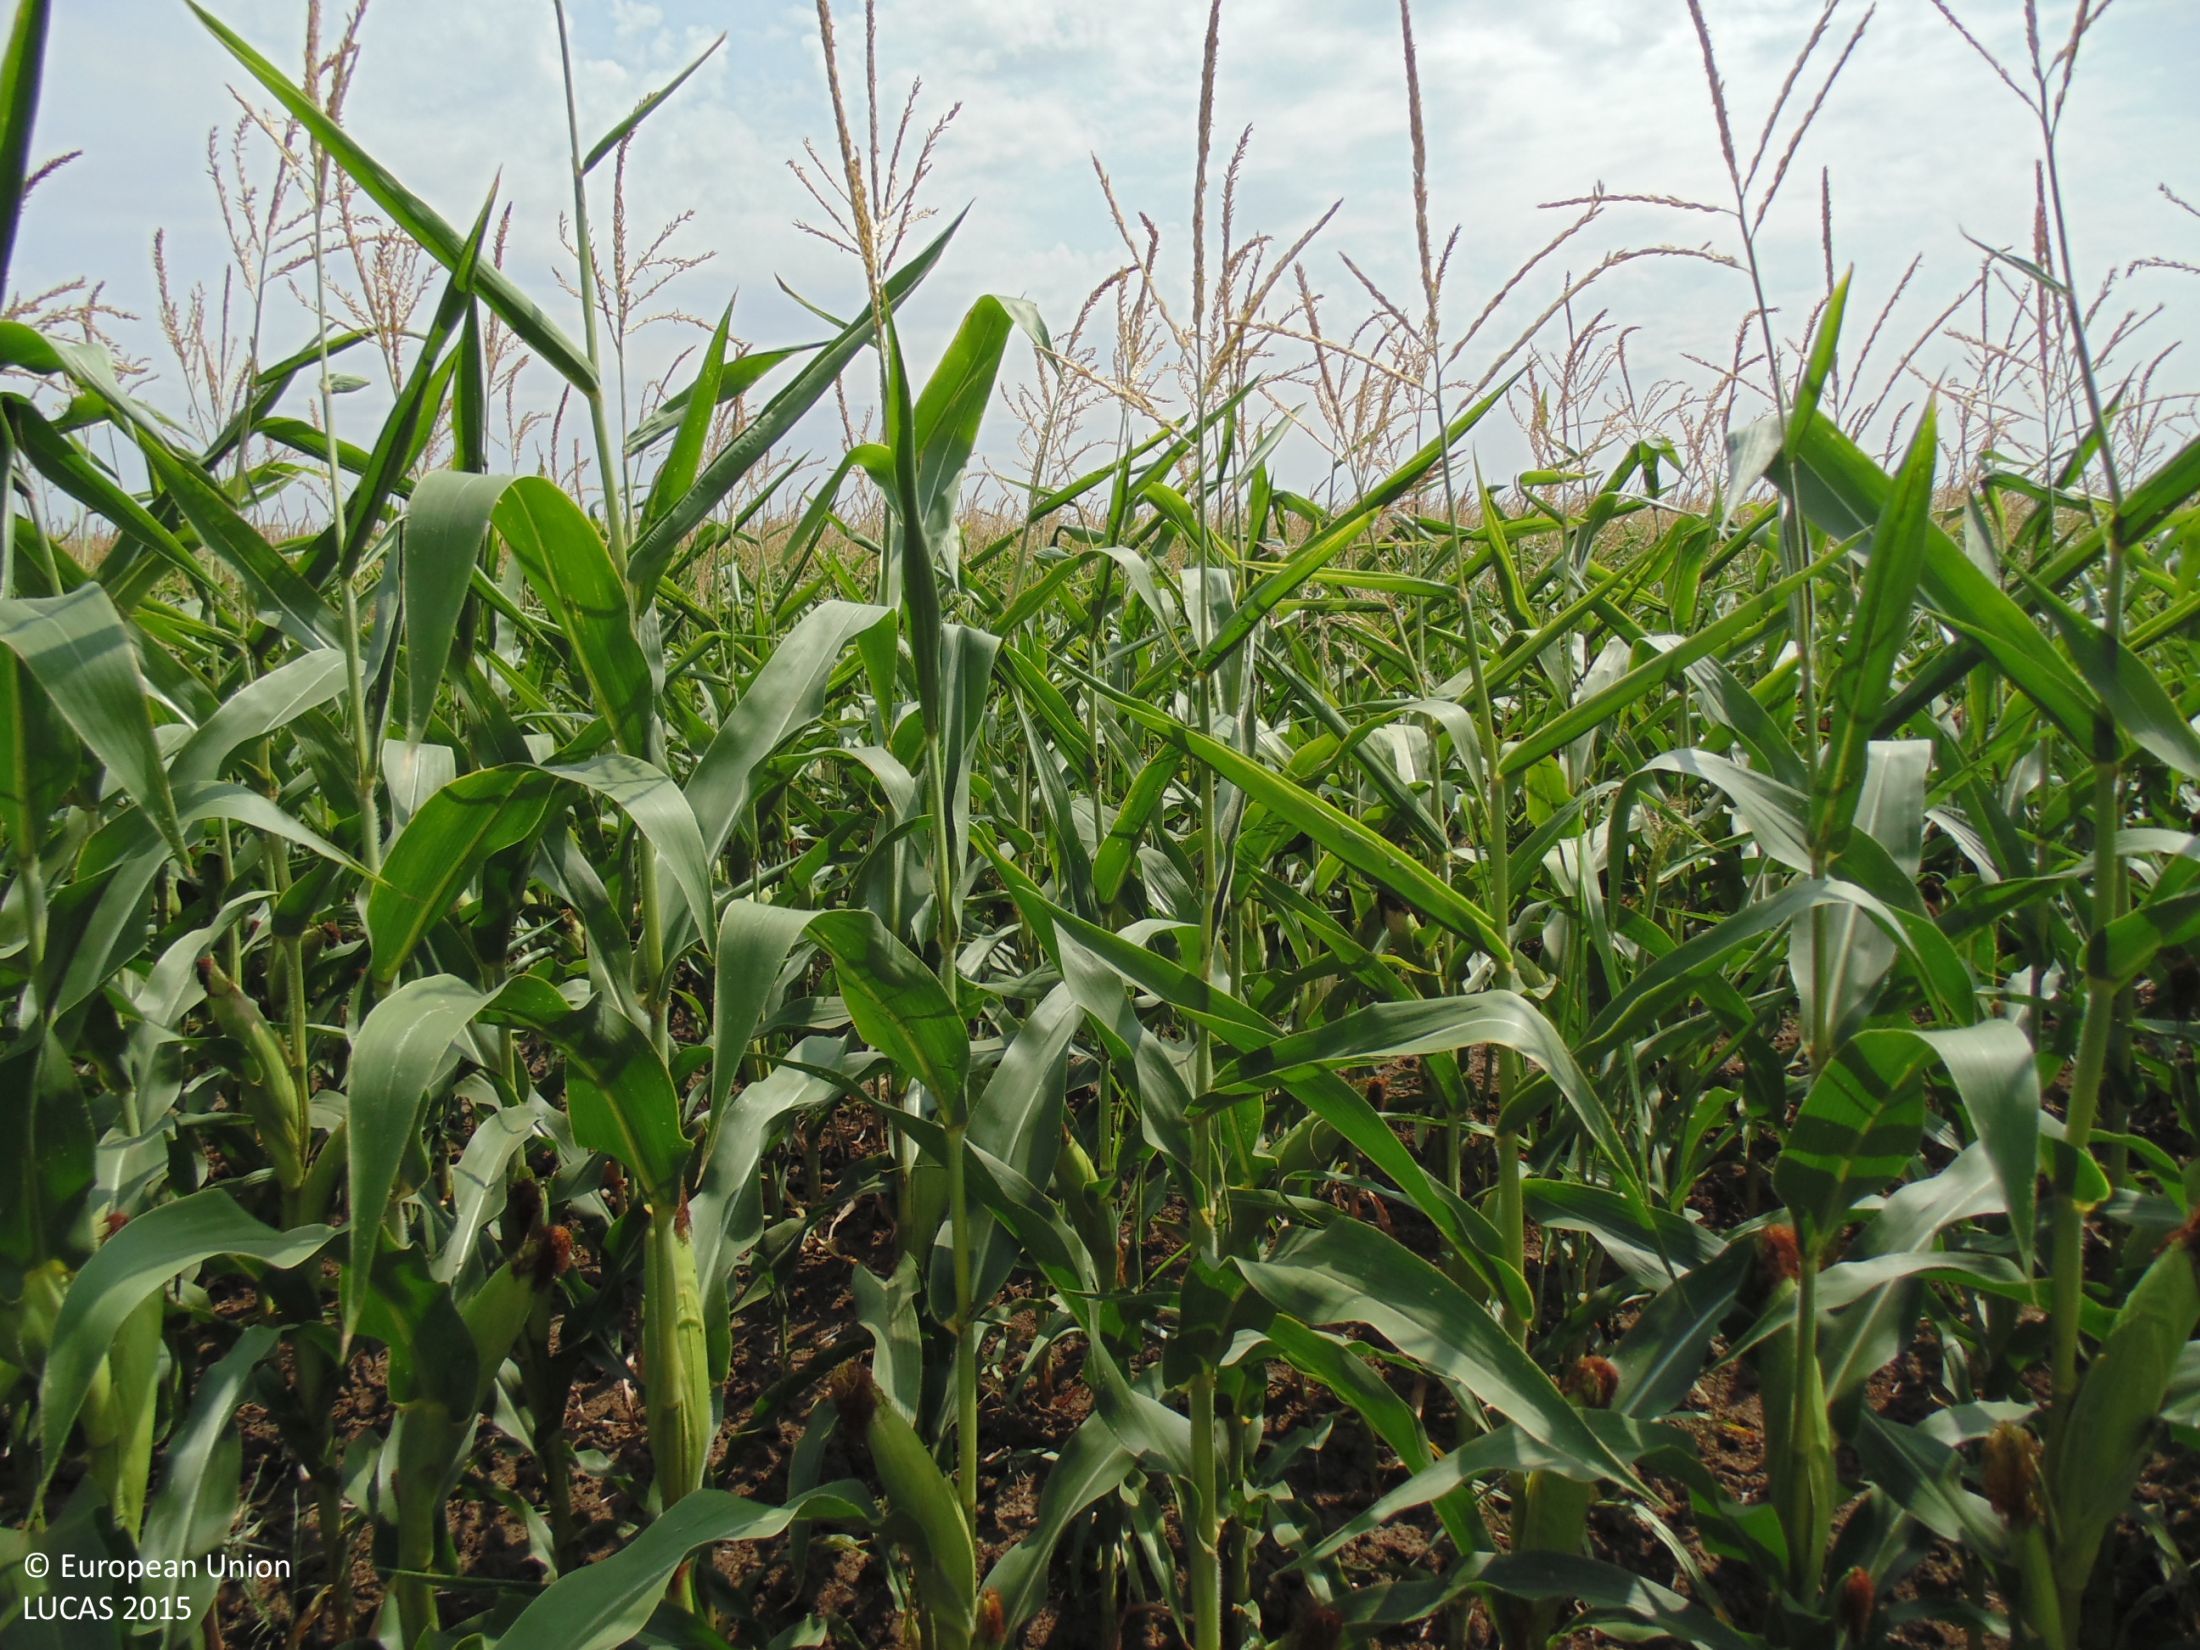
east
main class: Cropland
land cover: Maize
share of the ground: > 75 %
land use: Agriculture (excluding fallow land and kitchen gardens)
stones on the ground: < 10 %
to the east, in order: Maize; Grass margins; Sunflower
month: August
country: BG
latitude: 43.7922
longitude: 28.1105
